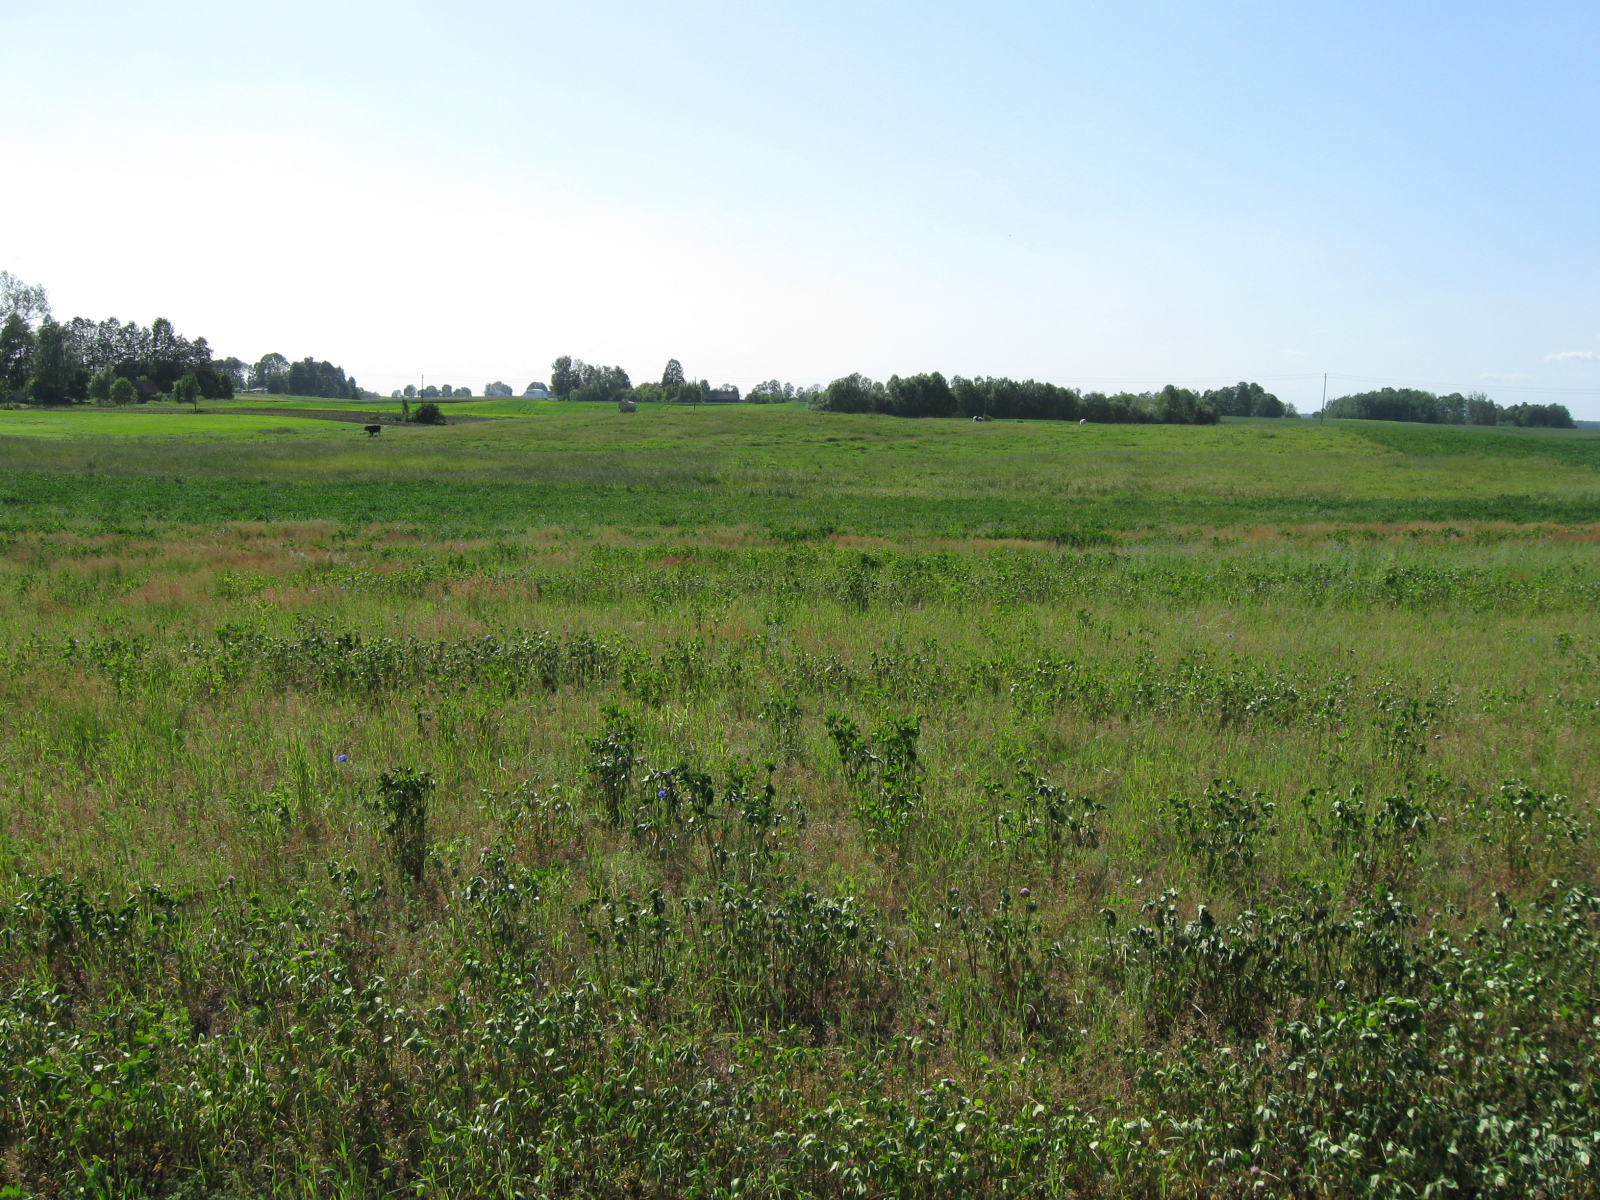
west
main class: Grassland
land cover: Spontaneously vegetated surfaces
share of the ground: > 75 %
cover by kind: herbaceous plants 100 %
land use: Fallow land
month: June
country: LT
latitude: 54.4469
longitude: 23.6717
